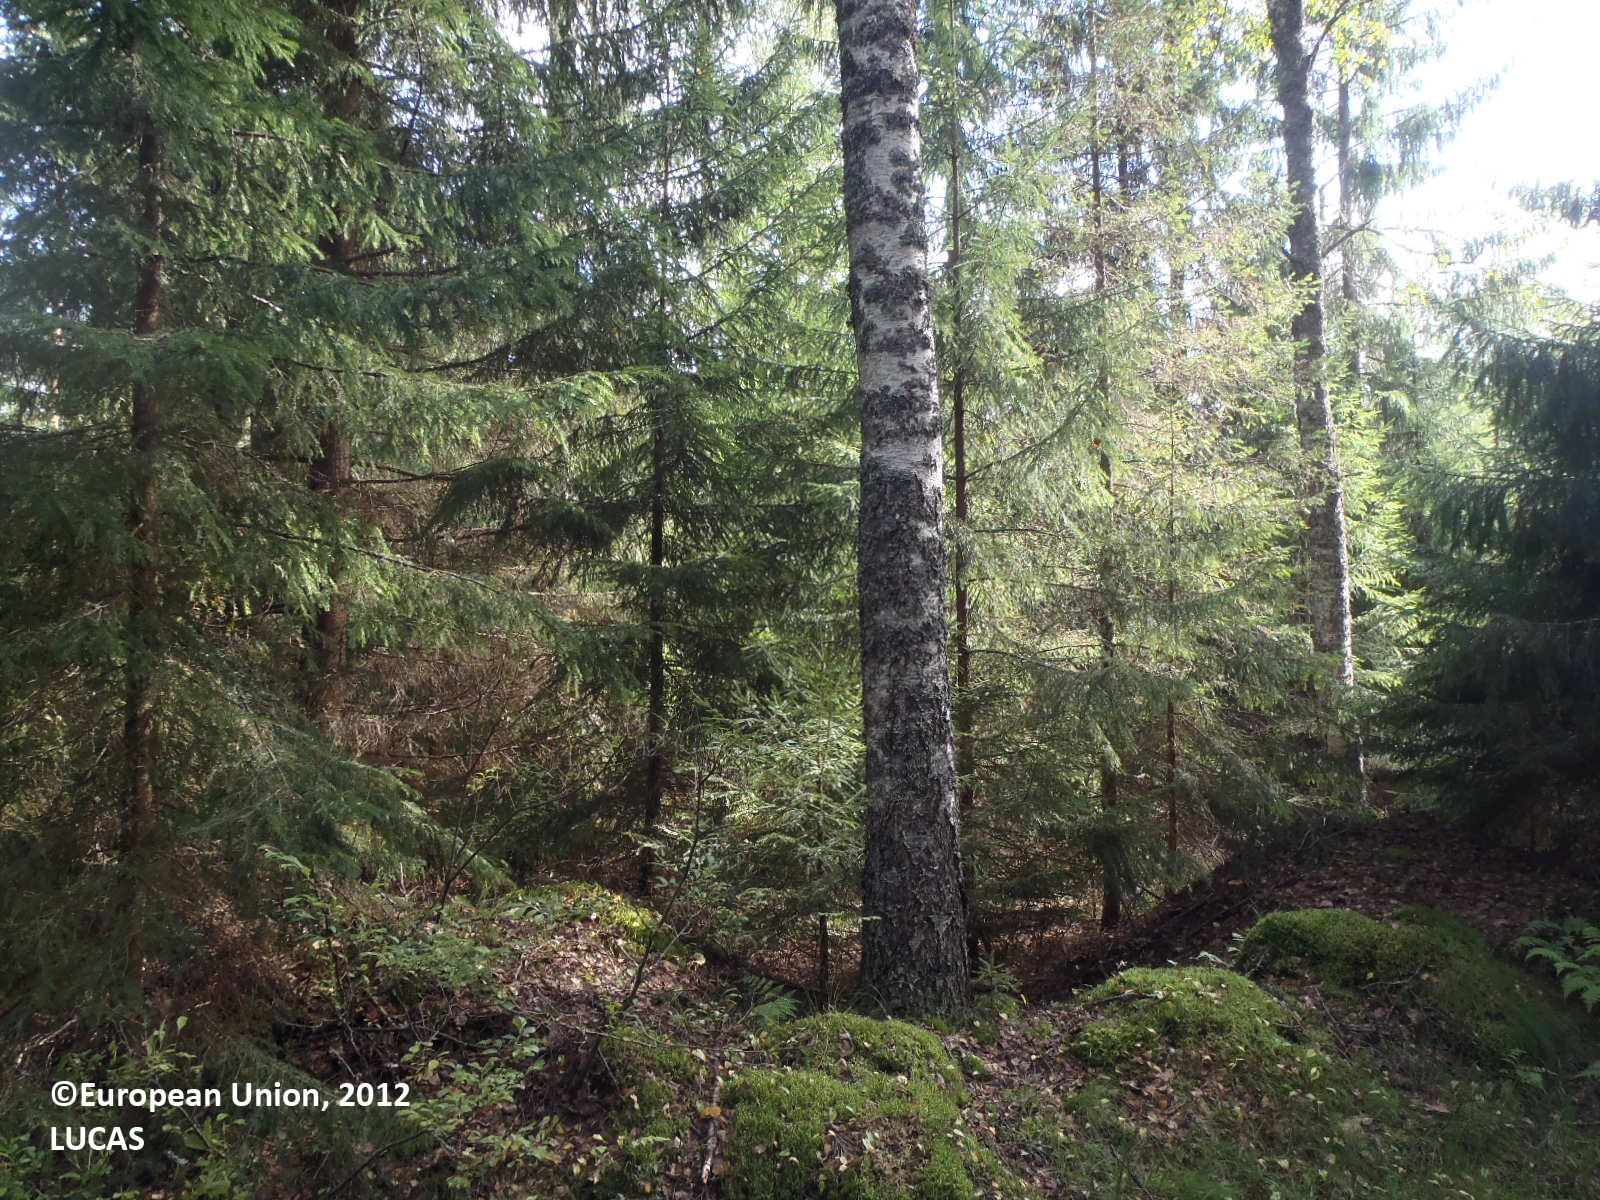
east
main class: Woodland
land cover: Other mixed woodland
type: boreal forest
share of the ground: > 75 %
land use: Forestry
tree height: > 5 m
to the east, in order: Other mixed woodland; Pine dominated coniferous woodland
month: August
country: FI
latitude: 60.7563
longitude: 22.2683
